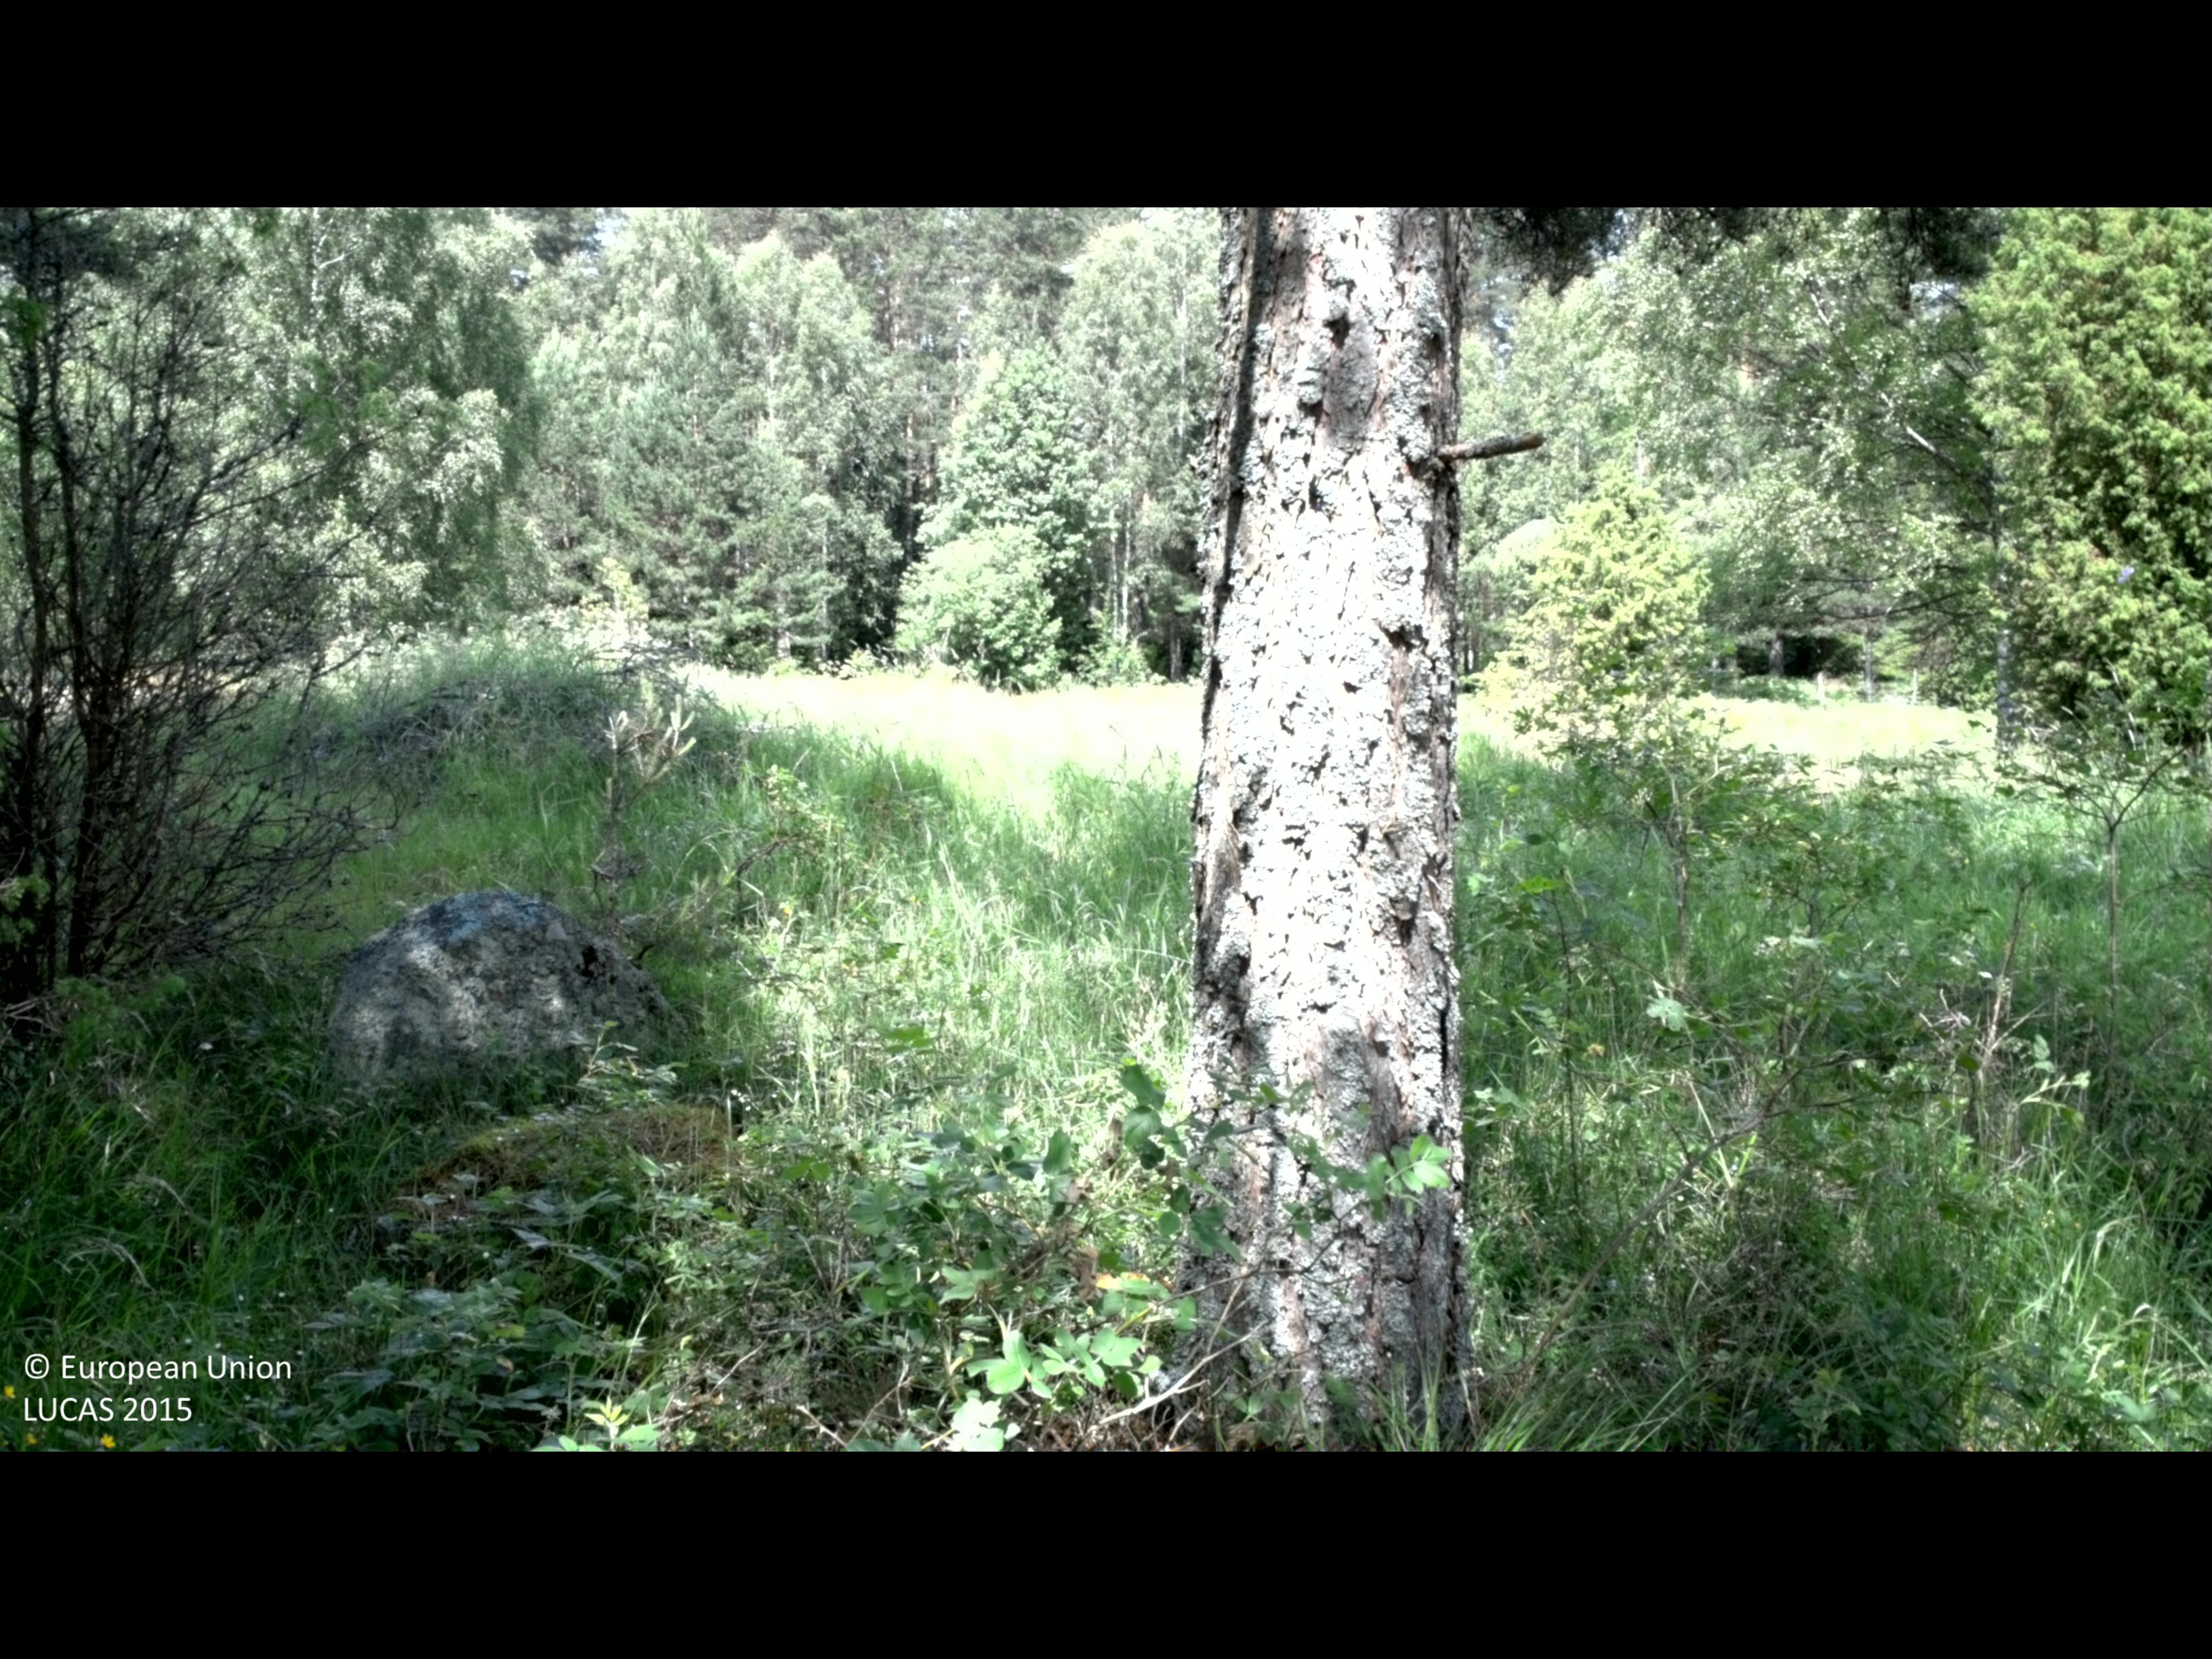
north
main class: Woodland
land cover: Pine dominated mixed woodland
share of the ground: 25 - 50 %
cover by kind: herbaceous plants 35 %, coniferous forest trees 30 %, shrubs 20 %, broadleaved forest trees 15 %
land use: Agriculture (excluding fallow land and kitchen gardens)
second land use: Forestry
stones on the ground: 25 - 50 %
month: June
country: SE
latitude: 58.0221
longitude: 16.5835
